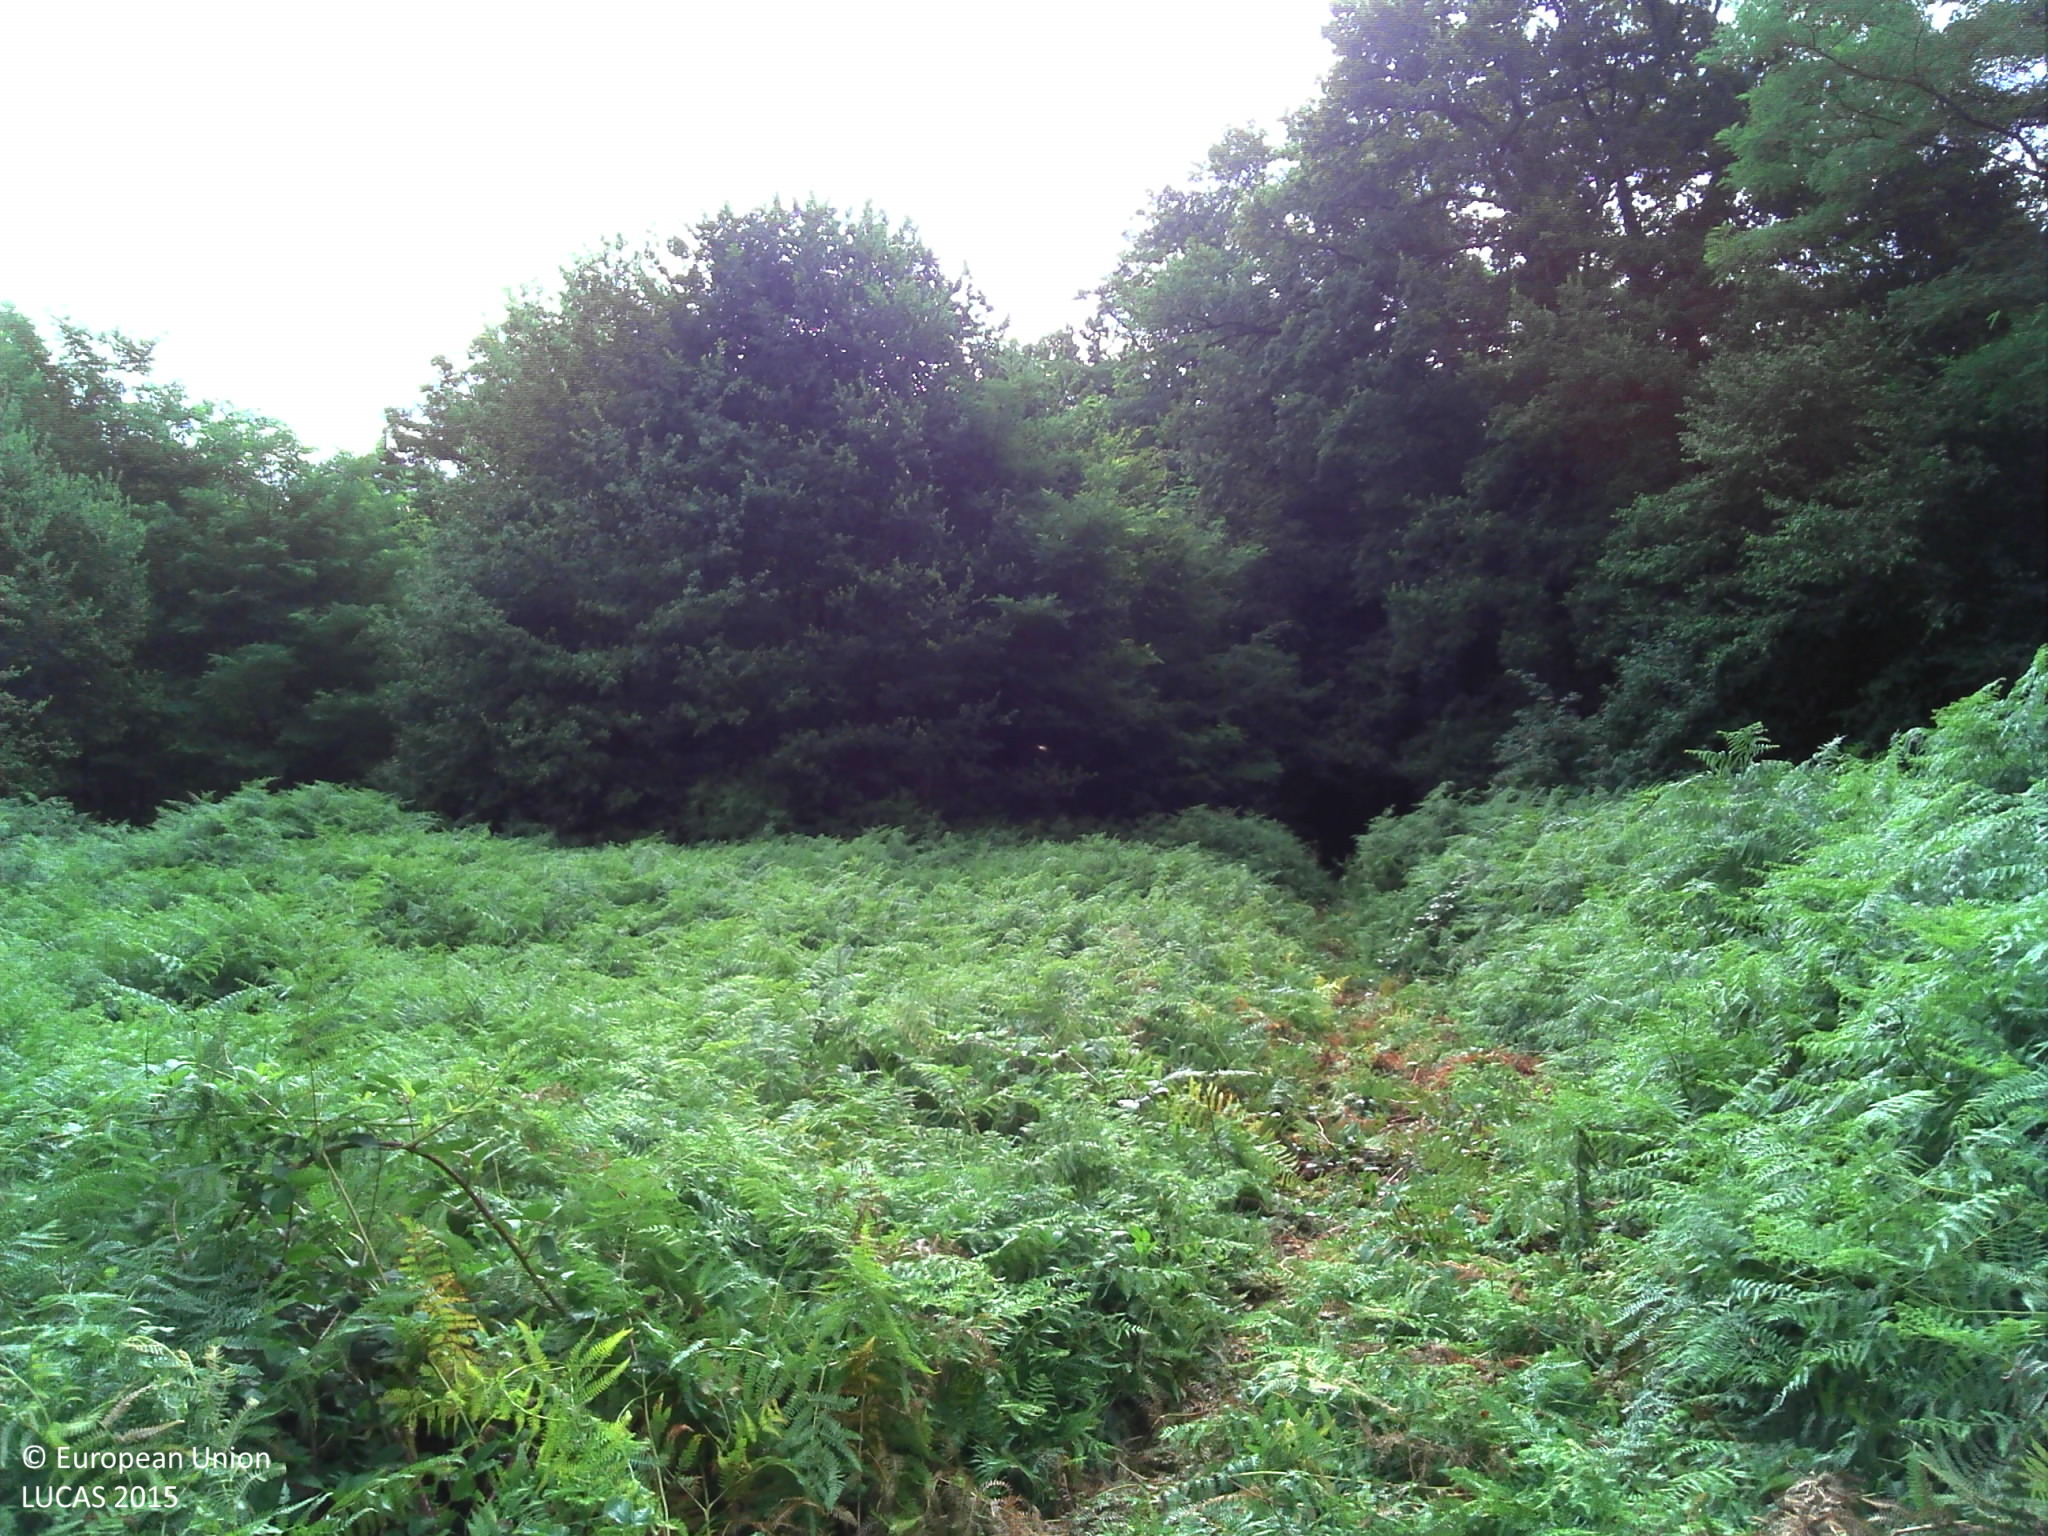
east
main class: Grassland
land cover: Spontaneously vegetated surfaces
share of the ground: > 75 %
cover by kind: herbaceous plants 95 %
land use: Forestry
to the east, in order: Spontaneously vegetated surfaces; Broadleaved woodland; Tracks; Broadleaved woodland; Tracks; Fences; Lines of trees; Grassland without tree/shrub cover; Tracks; Grassland without tree/shrub cover; Inland fresh water bodies
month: July
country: FR
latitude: 45.7639
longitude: 1.3382
